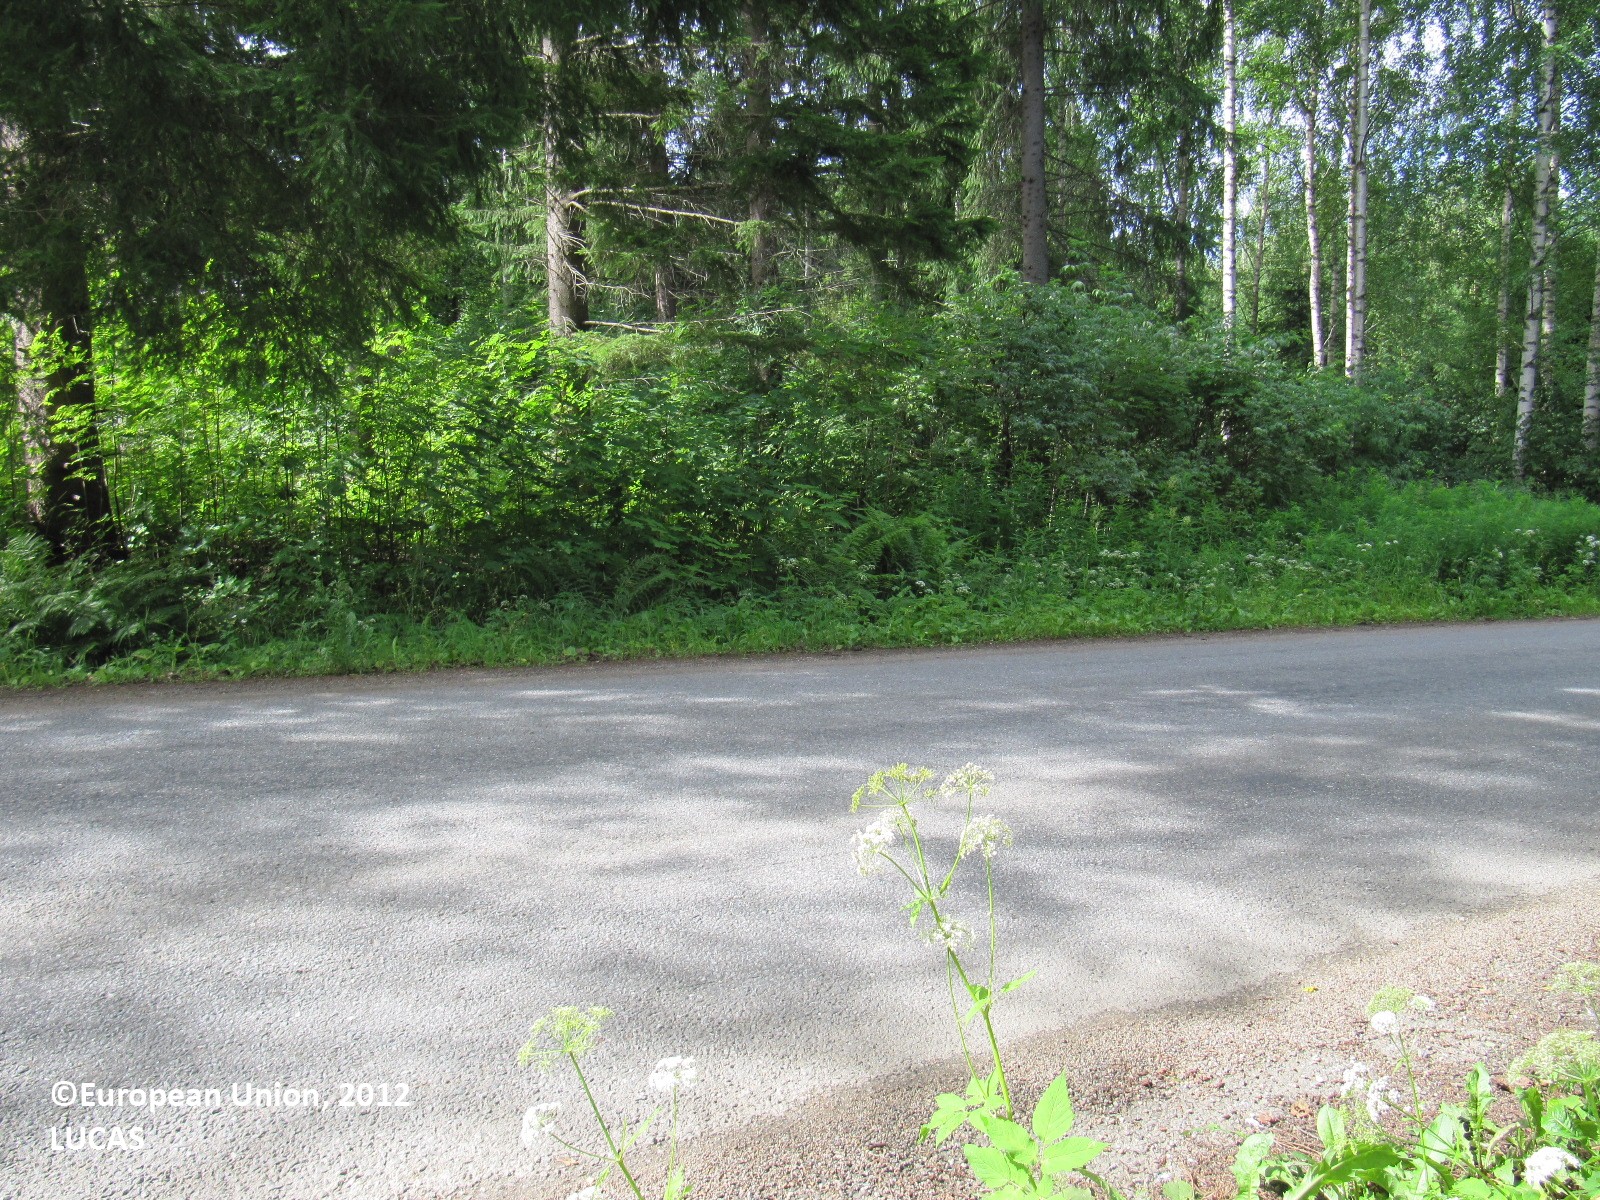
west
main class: Woodland
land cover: Broadleaved woodland
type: boreal forest
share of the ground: > 75 %
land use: Forestry
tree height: > 5 m
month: July
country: FI
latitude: 61.1718
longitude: 24.6616
